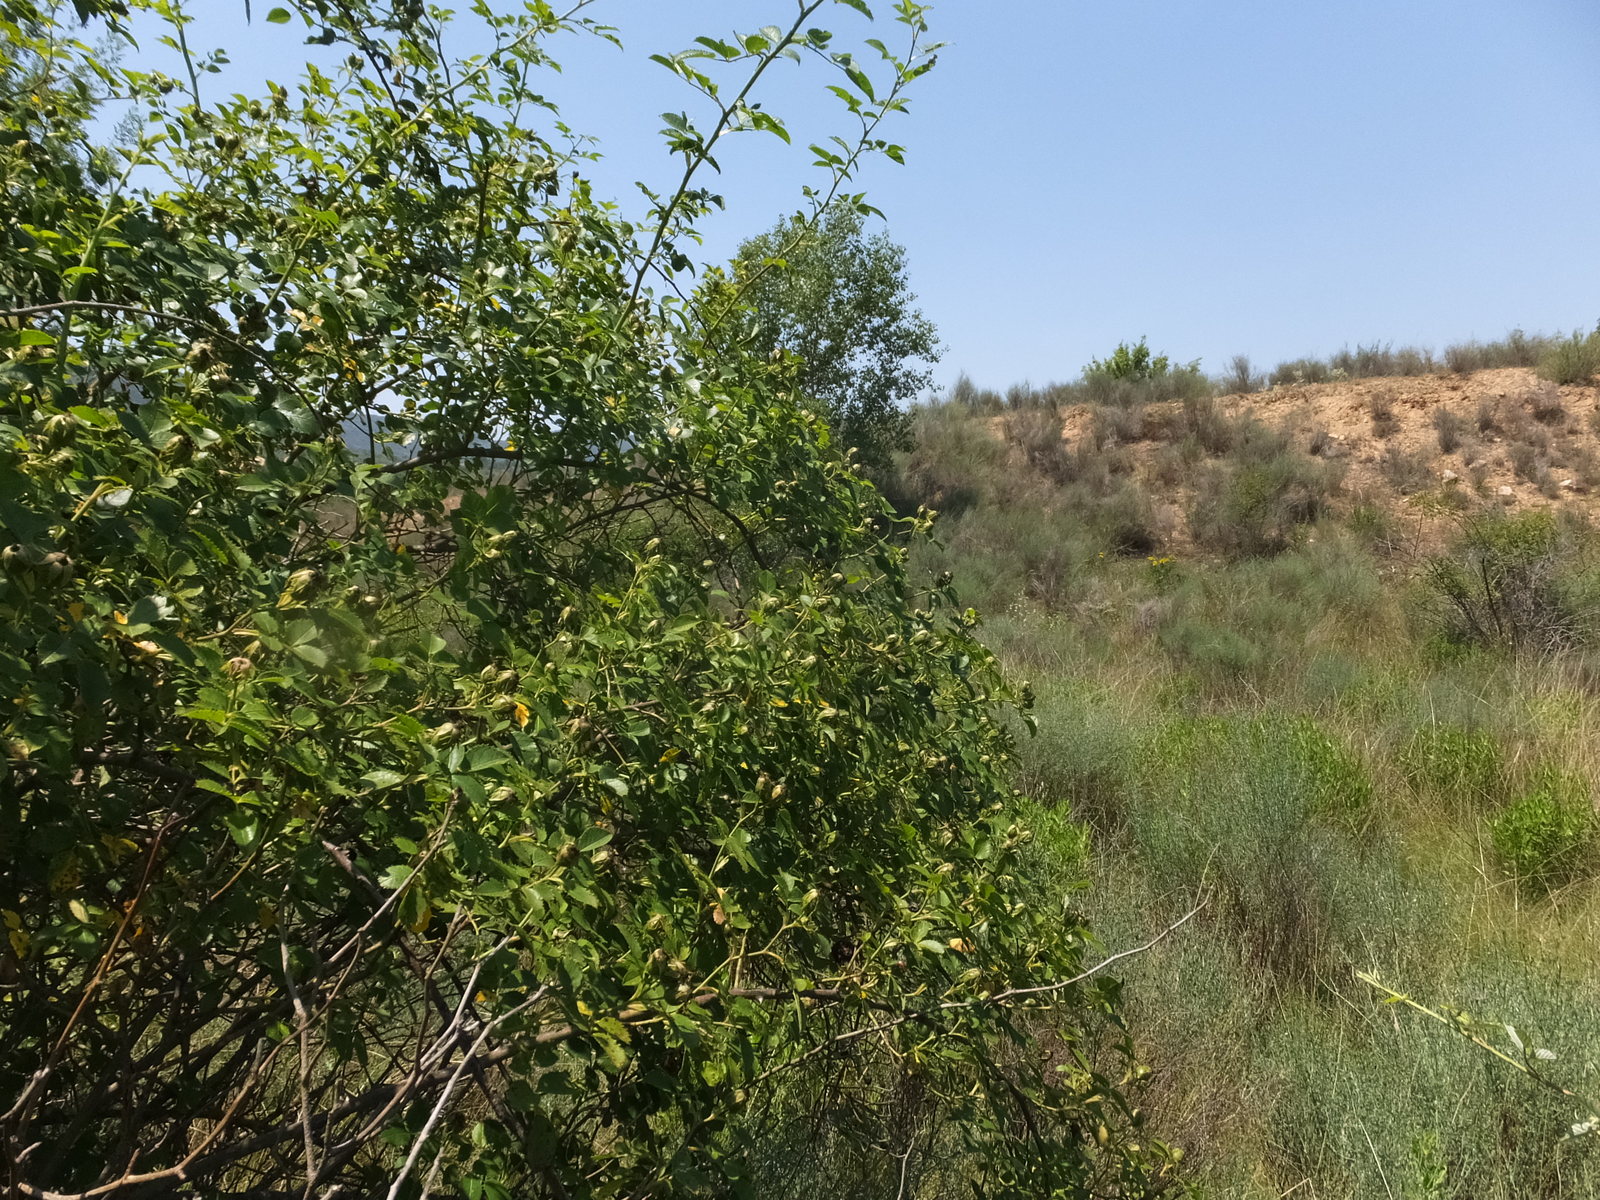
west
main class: Shrubland
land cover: Shrubland with sparse tree cover
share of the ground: 50 - 75 %
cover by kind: shrubs 70 %, herbaceous plants 25 %, broadleaved forest trees 5 %
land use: Semi-natural and natural areas not in use
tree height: < 5 m
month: June
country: ES
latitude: 41.9043
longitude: 0.5704
